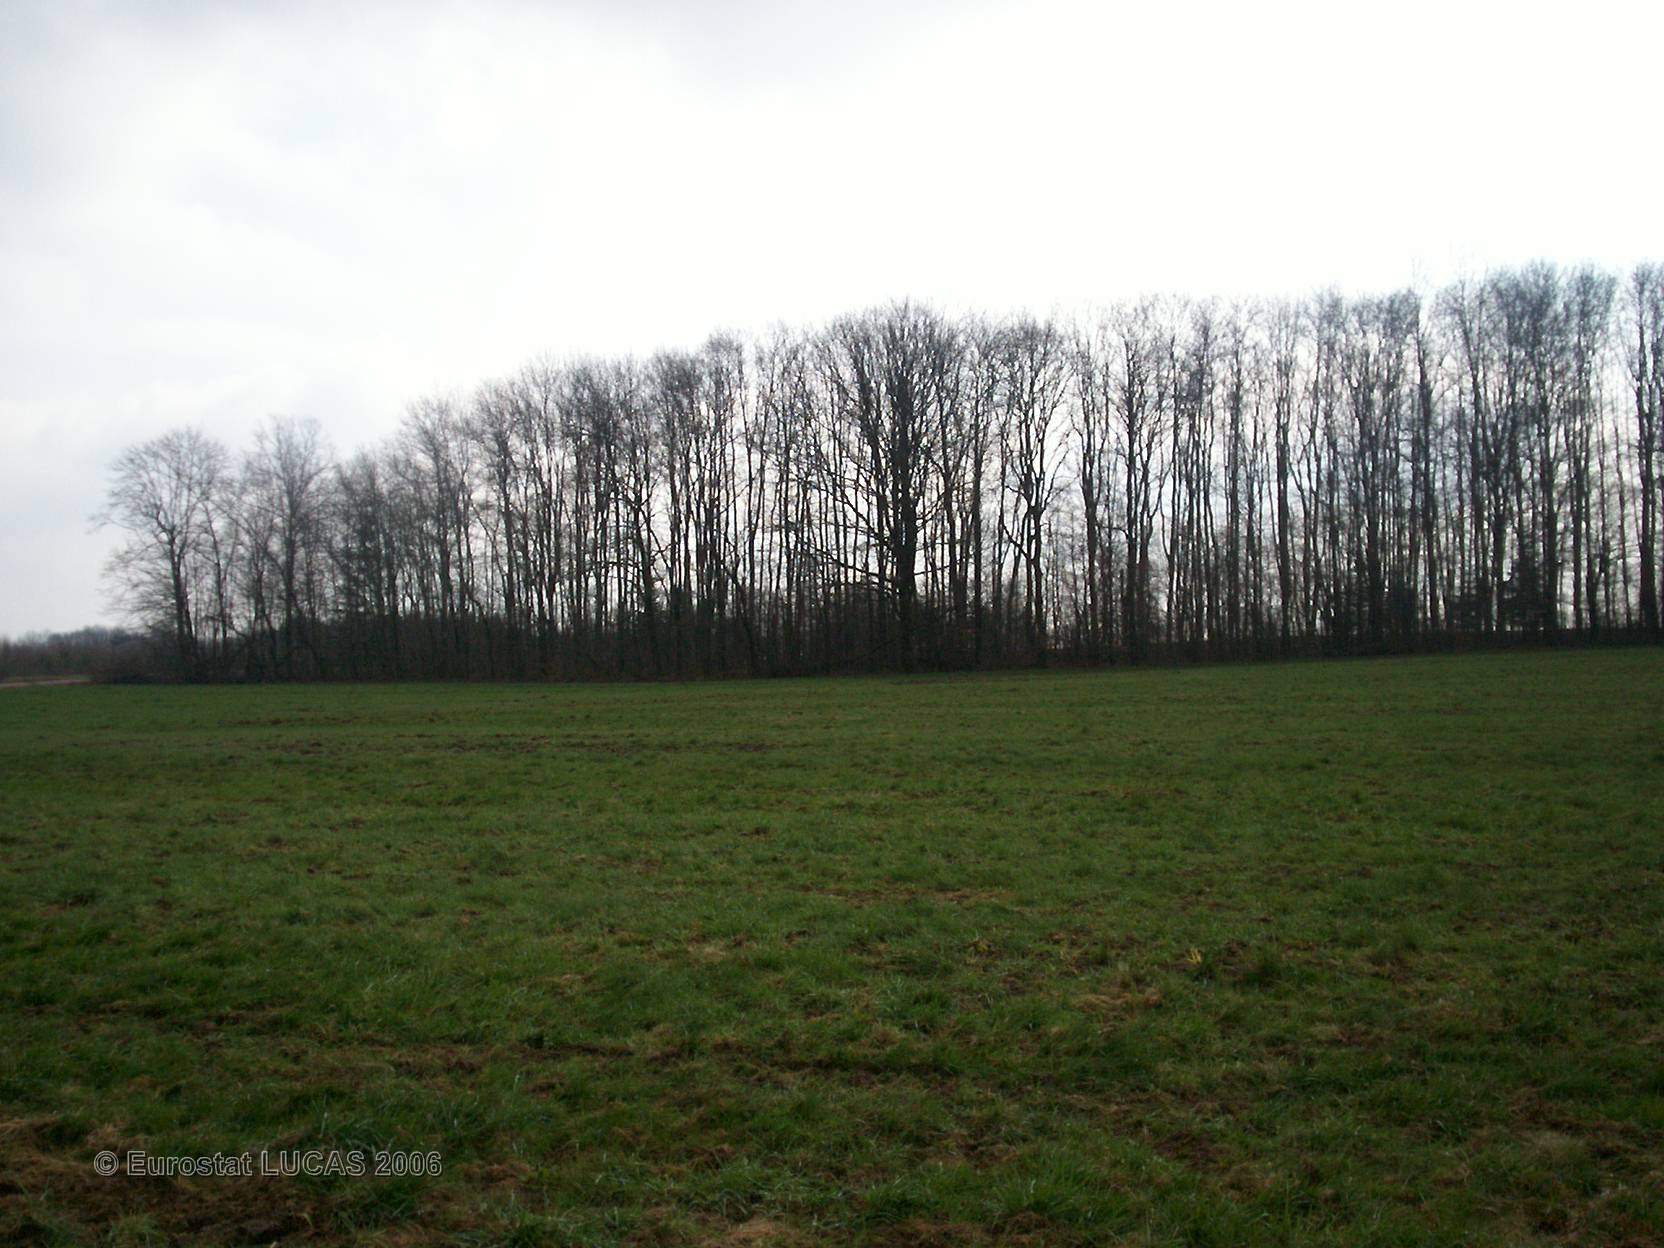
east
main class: Grassland
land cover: Grassland without tree/shrub cover
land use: Agriculture (excluding fallow land and kitchen gardens)
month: April
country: FR
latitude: 48.0879
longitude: 6.2550
